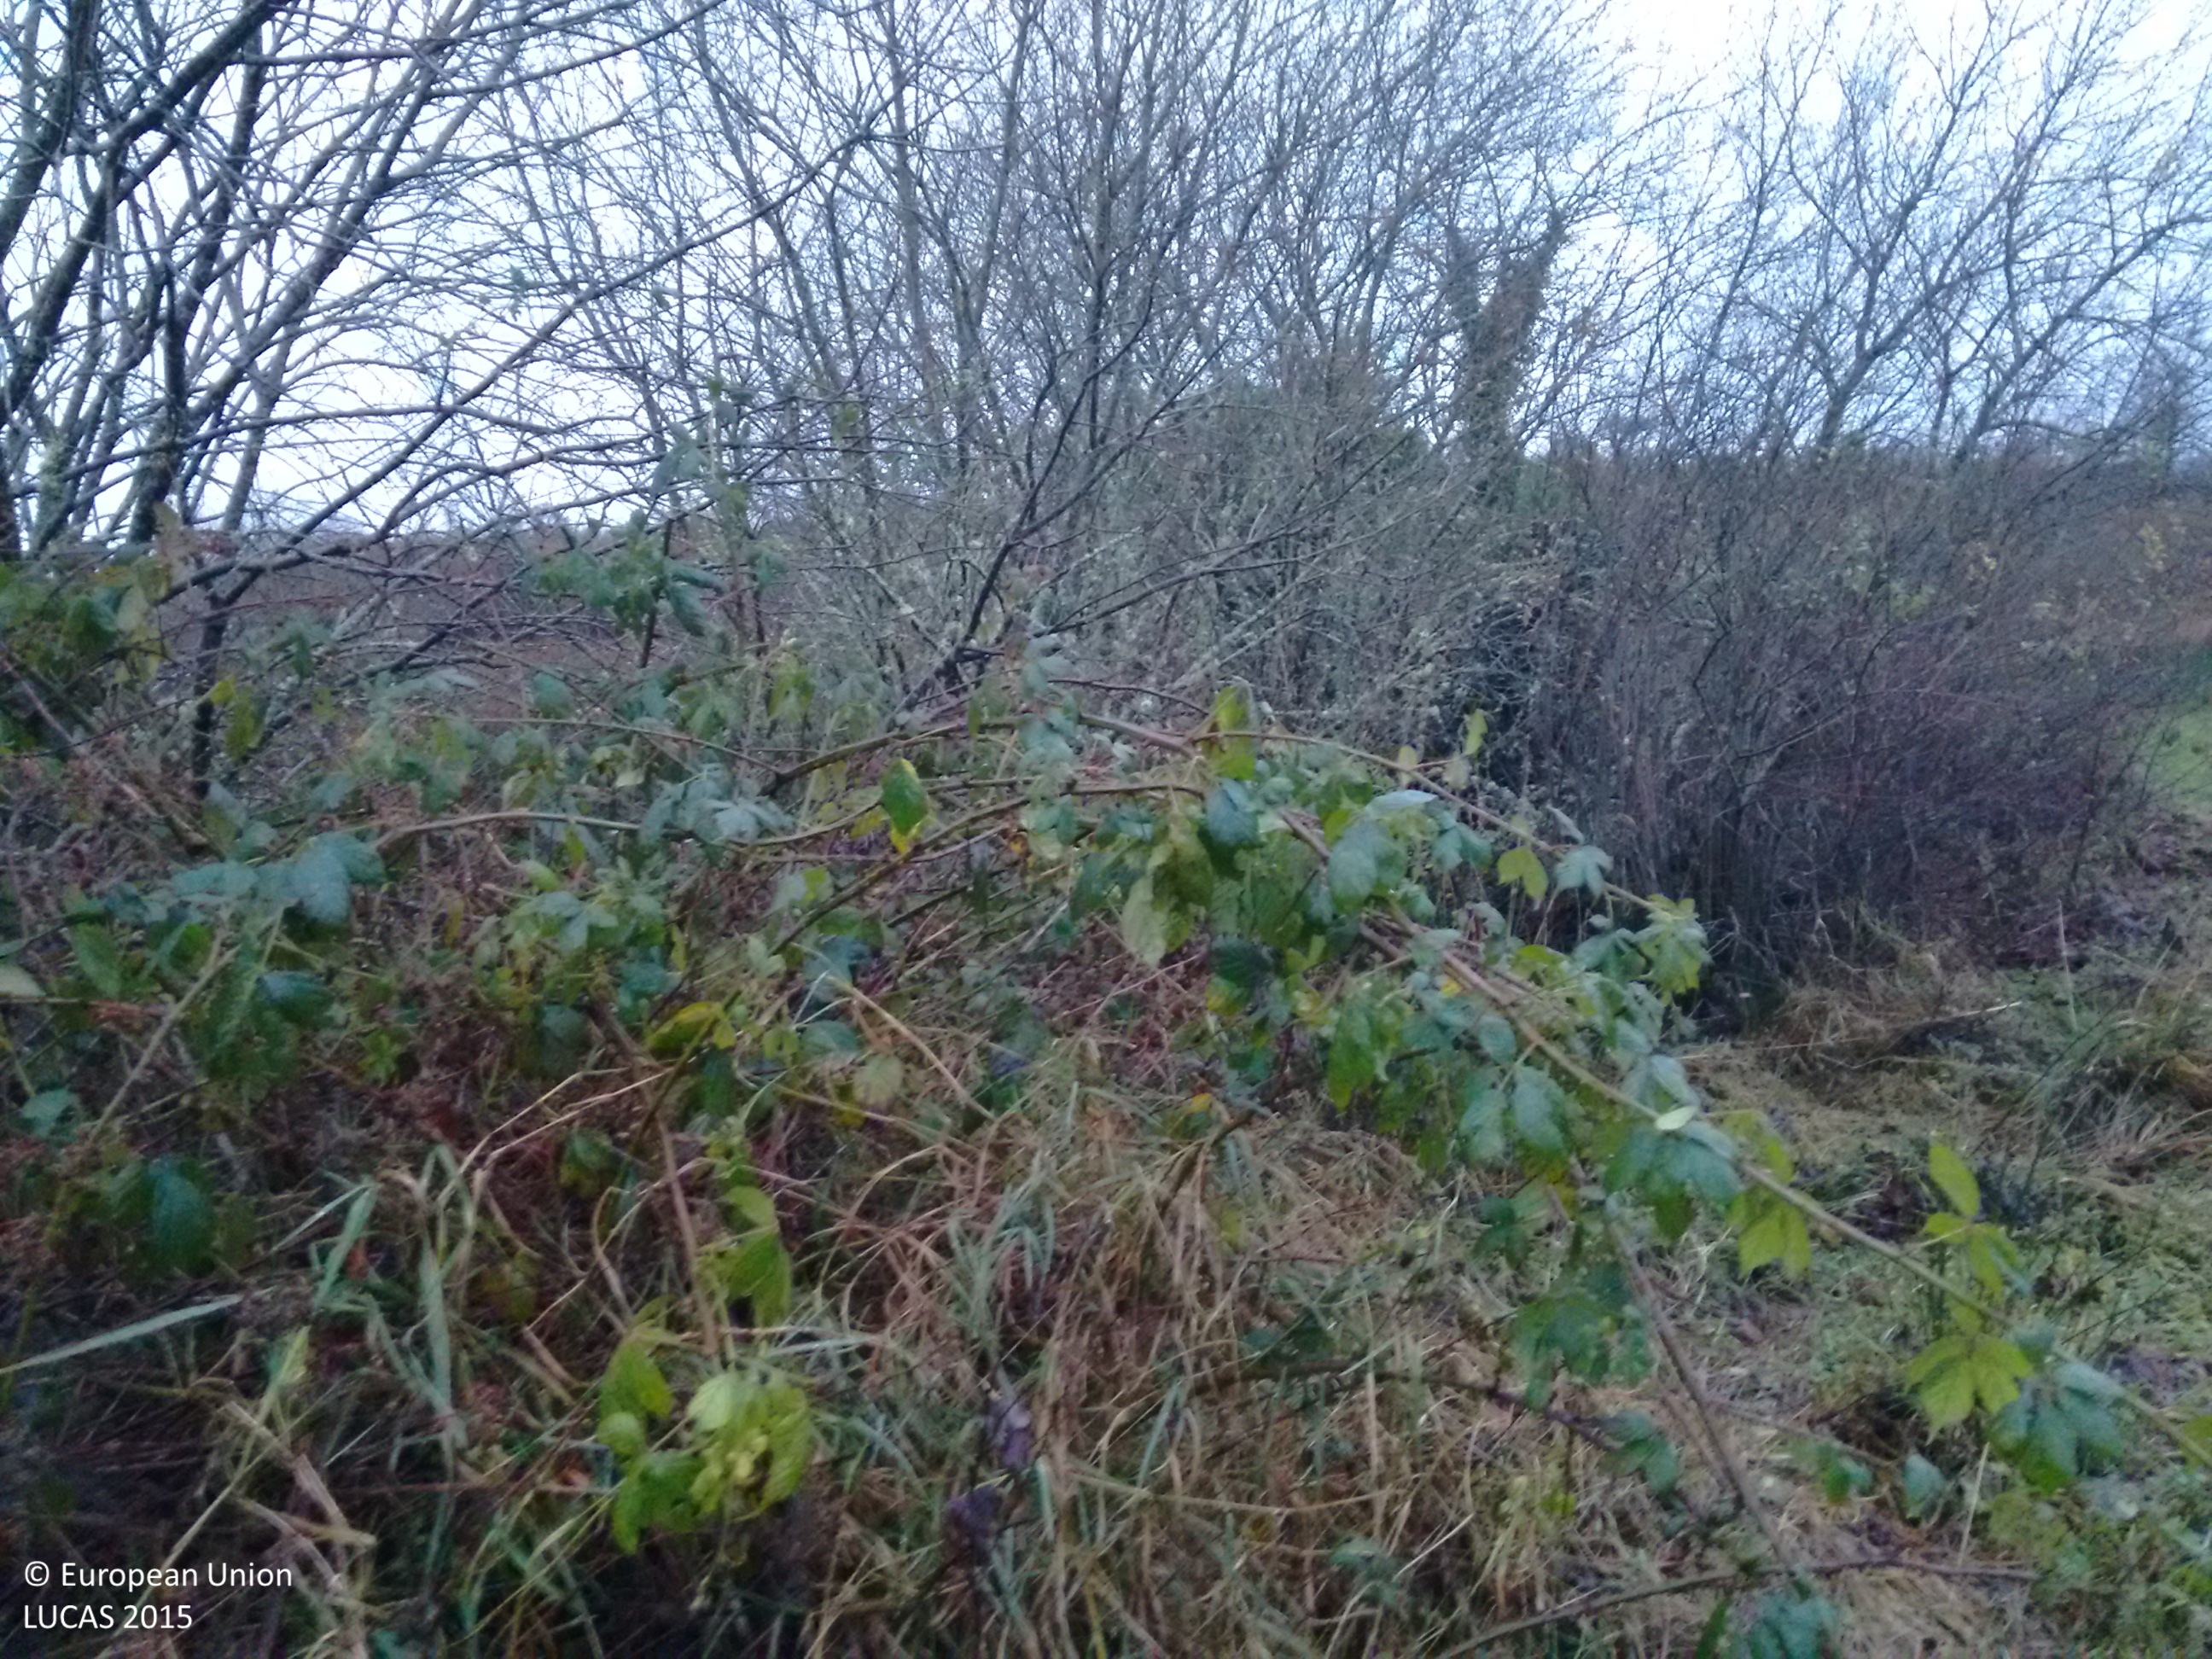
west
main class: Woodland
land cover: Spruce dominated coniferous woodland
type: exotic forest
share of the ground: > 75 %
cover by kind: coniferous forest trees 100 %
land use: Forestry
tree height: > 5 m
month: December
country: IE
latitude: 54.2223
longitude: -7.9480
